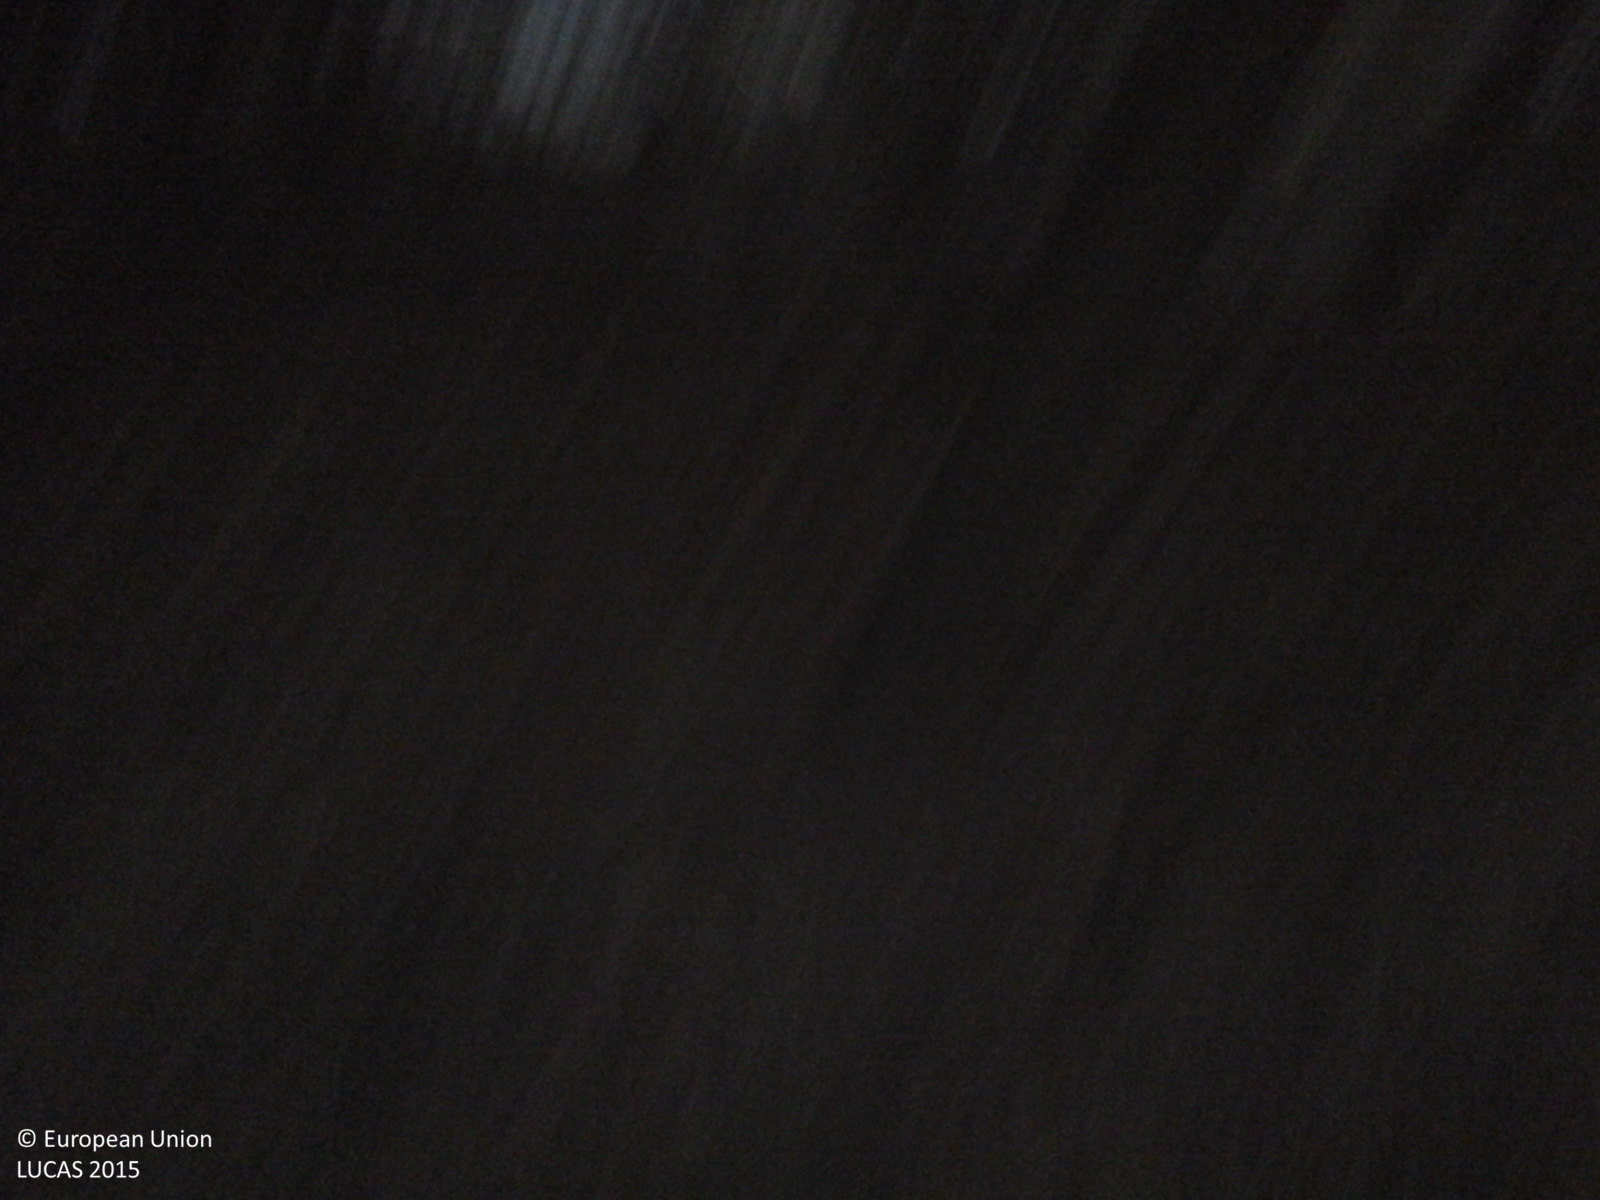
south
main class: Woodland
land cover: Broadleaved woodland
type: thermophilous deciduous forest
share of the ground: > 75 %
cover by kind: broadleaved forest trees 80 %, shrubs 10 %, herbaceous plants 10 %
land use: Semi-natural and natural areas not in use
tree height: > 5 m
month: September
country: IT
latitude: 44.2278
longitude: 8.2639
